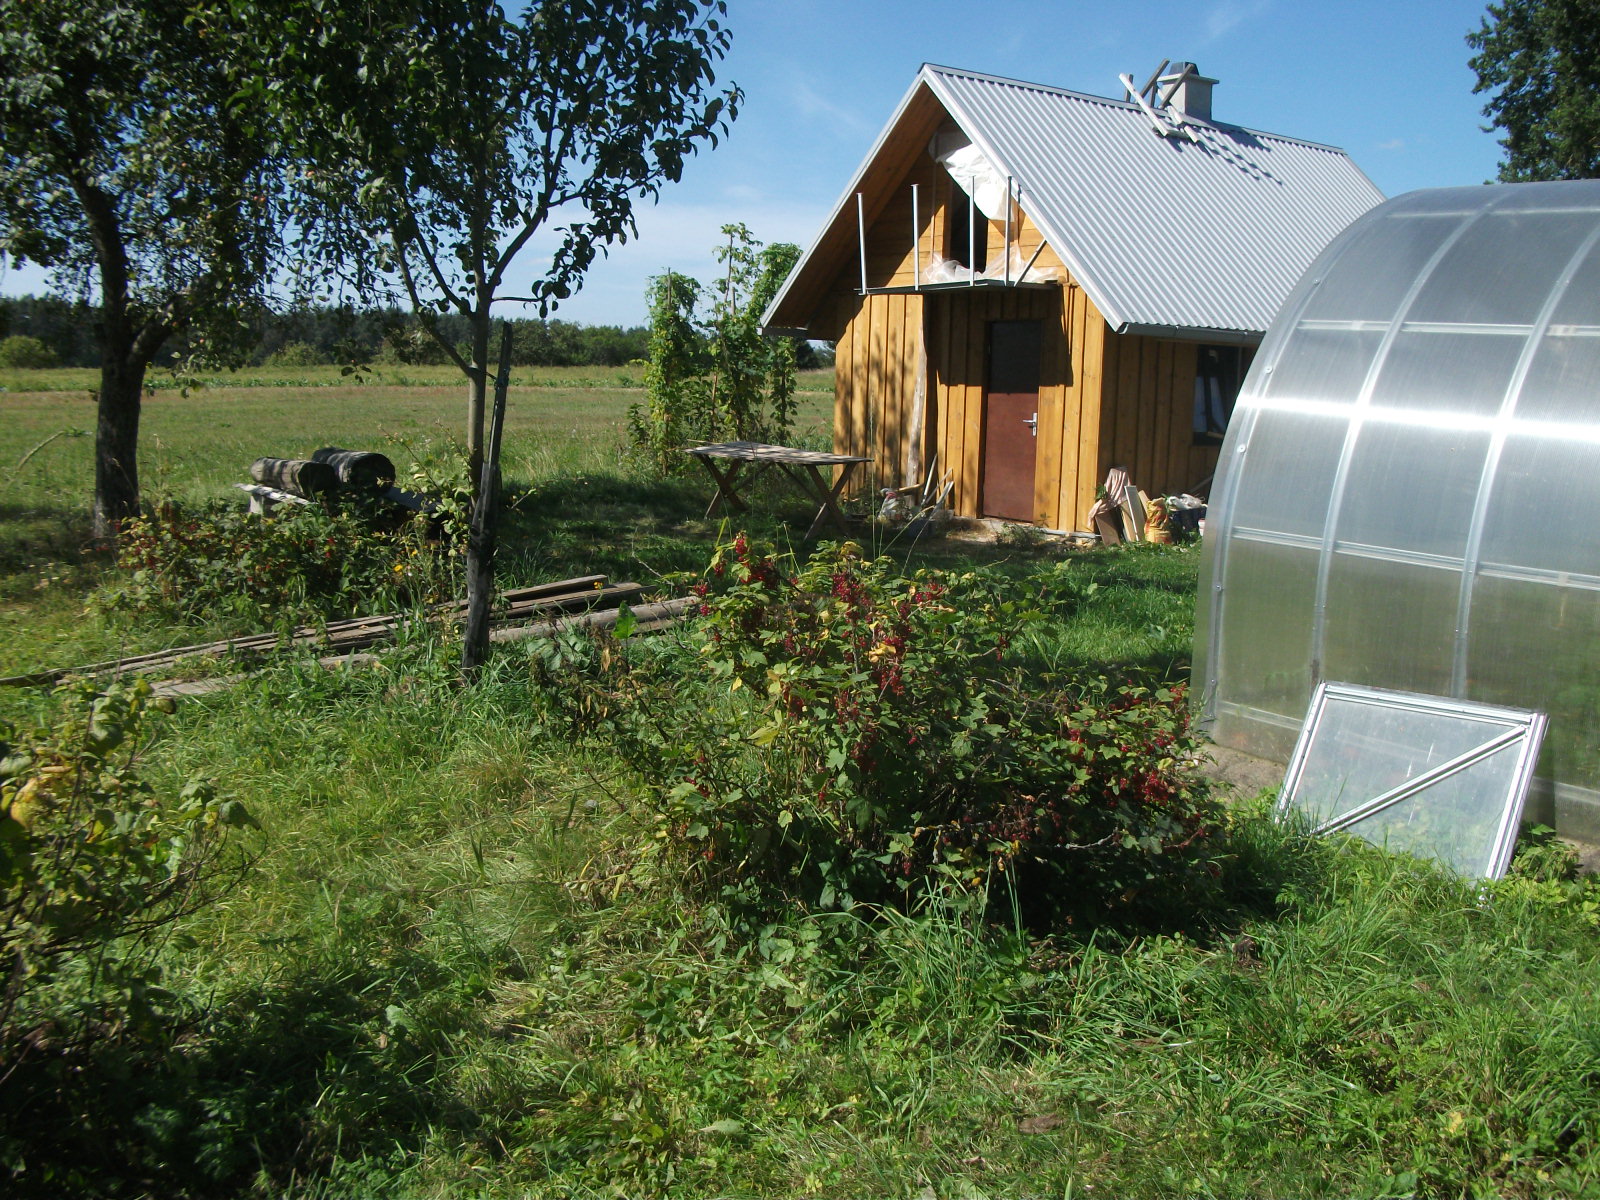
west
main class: Cropland
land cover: Apple fruit
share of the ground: 10 - 25 %
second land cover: Grassland without tree/shrub cover
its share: > 75 %
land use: Kitchen garden
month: August
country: LV
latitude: 56.4539
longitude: 26.0526
